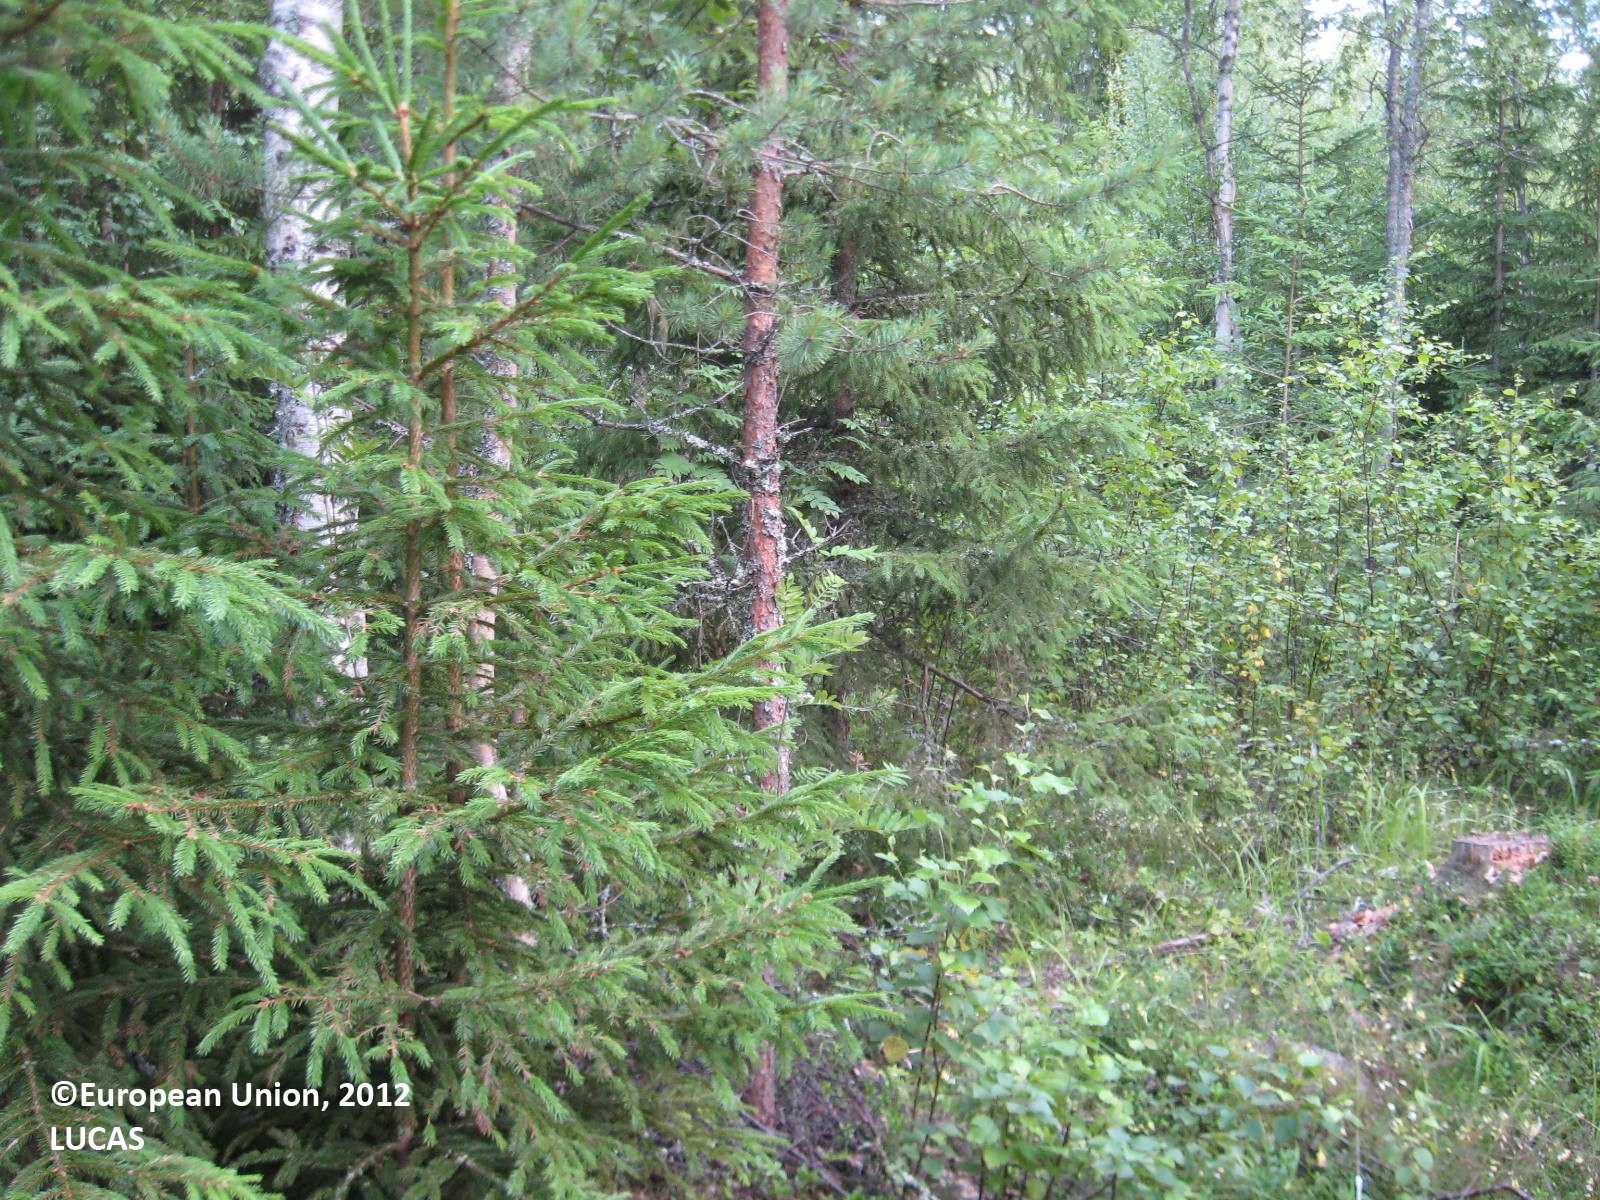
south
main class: Woodland
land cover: Other mixed woodland
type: boreal forest
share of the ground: > 75 %
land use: Forestry
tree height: > 5 m
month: July
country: FI
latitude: 62.3439
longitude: 21.3792
